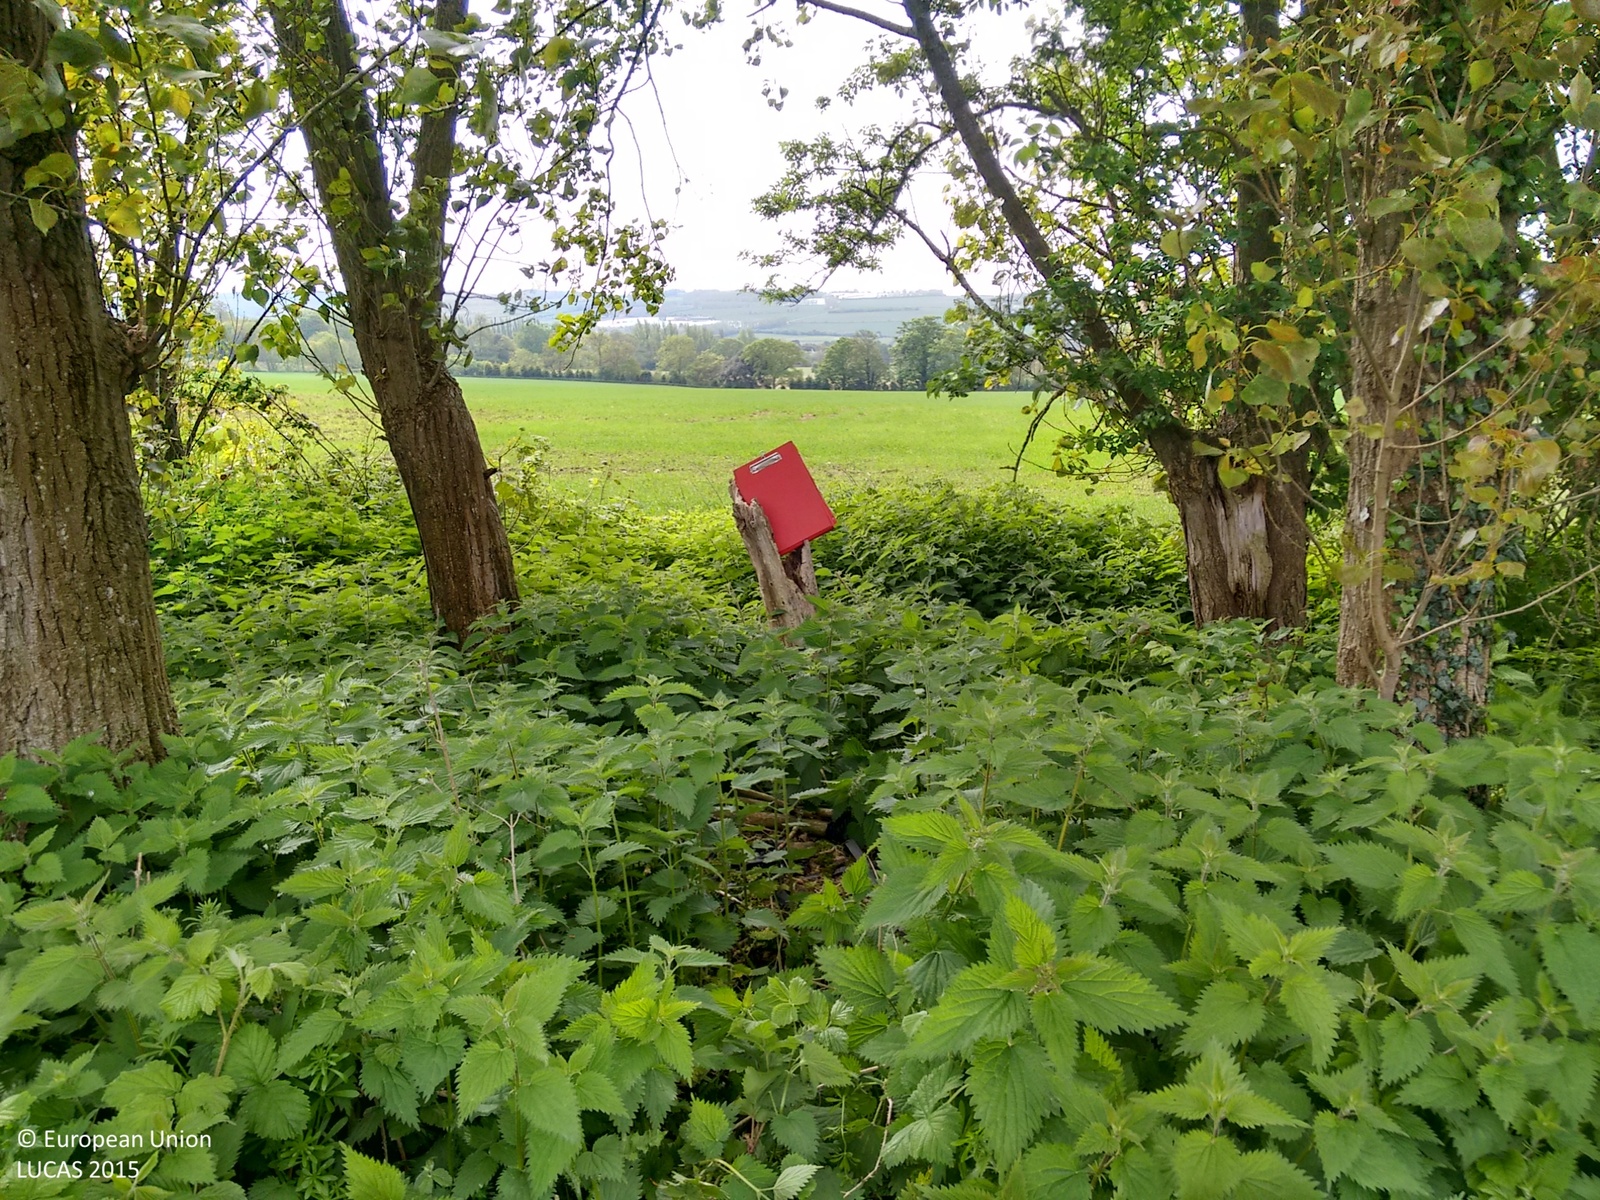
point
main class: Woodland
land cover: Broadleaved woodland
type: mesophytic deciduous forest
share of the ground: > 75 %
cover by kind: broadleaved forest trees 85 %, herbaceous plants 10 %, shrubs 5 %
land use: Forestry
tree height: > 5 m
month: May
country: GB
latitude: 51.2643
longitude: 0.4122
